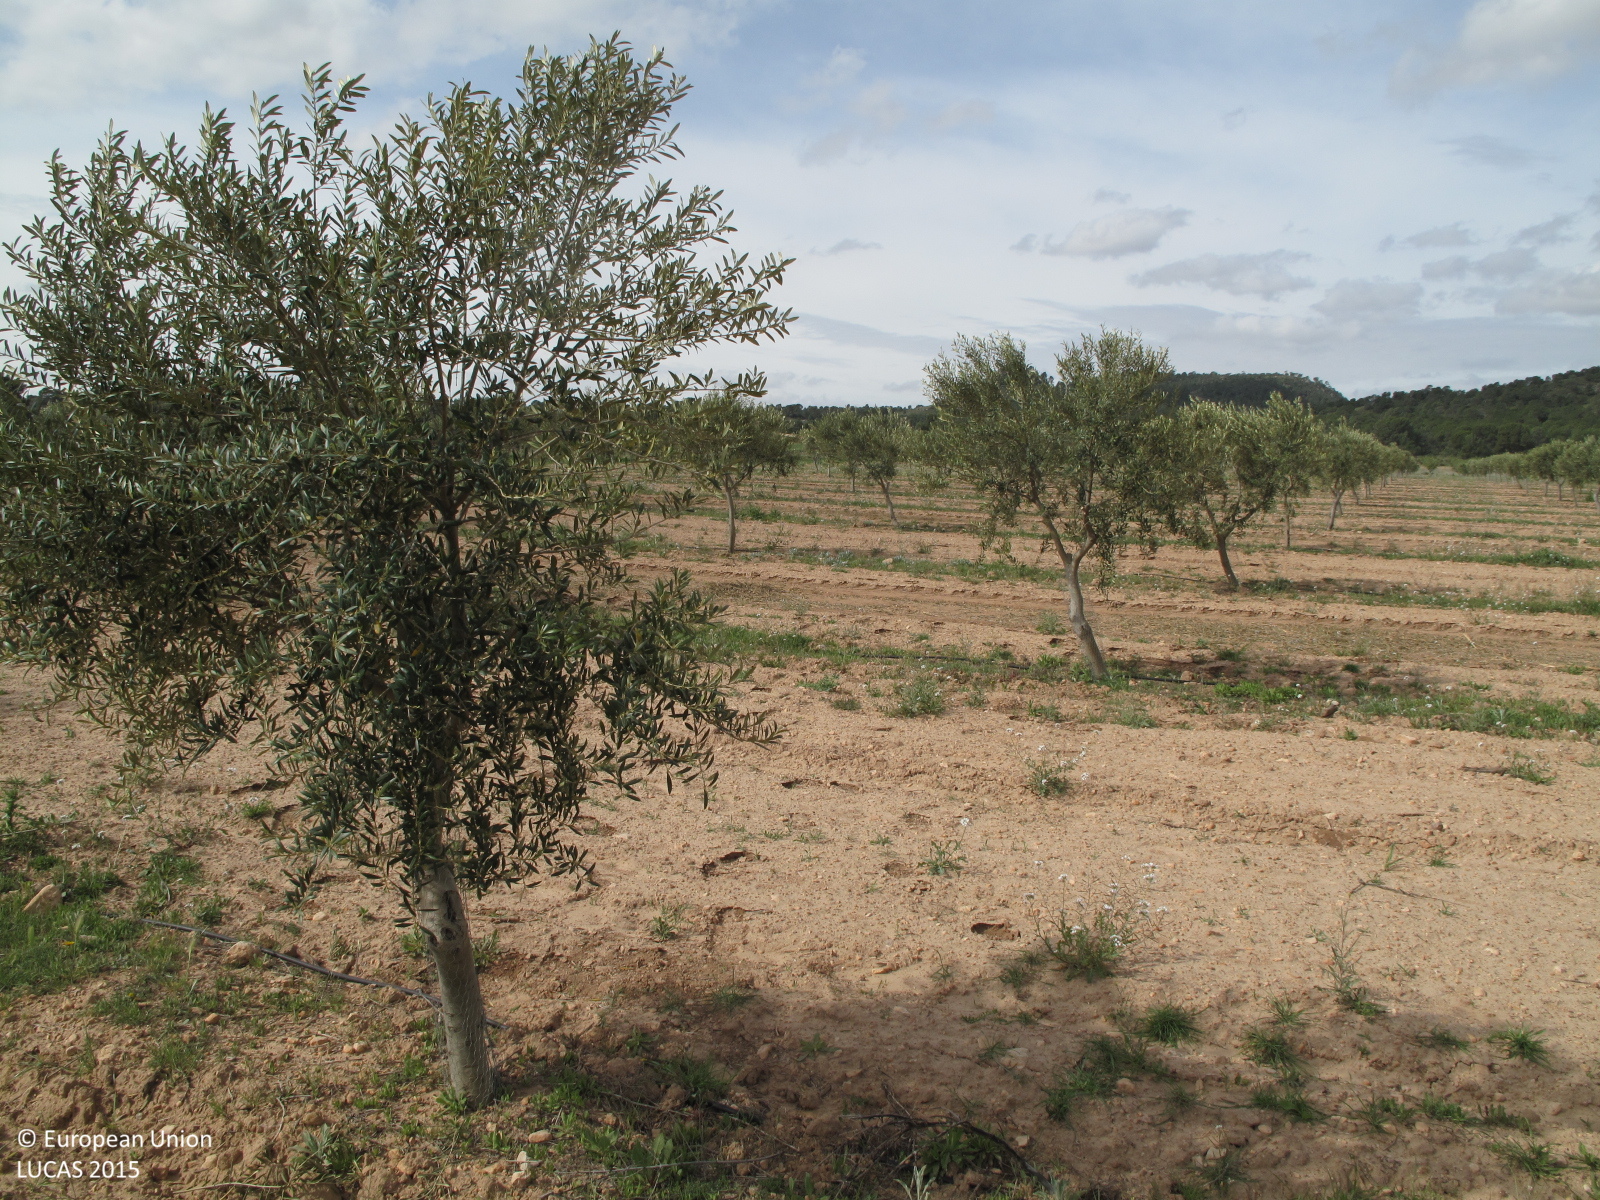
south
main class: Cropland
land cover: Olive groves
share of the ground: < 10 %
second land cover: Spontaneously vegetated surfaces
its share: < 10 %
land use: Agriculture (excluding fallow land and kitchen gardens)
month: April
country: ES
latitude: 38.6649
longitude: -0.9666
